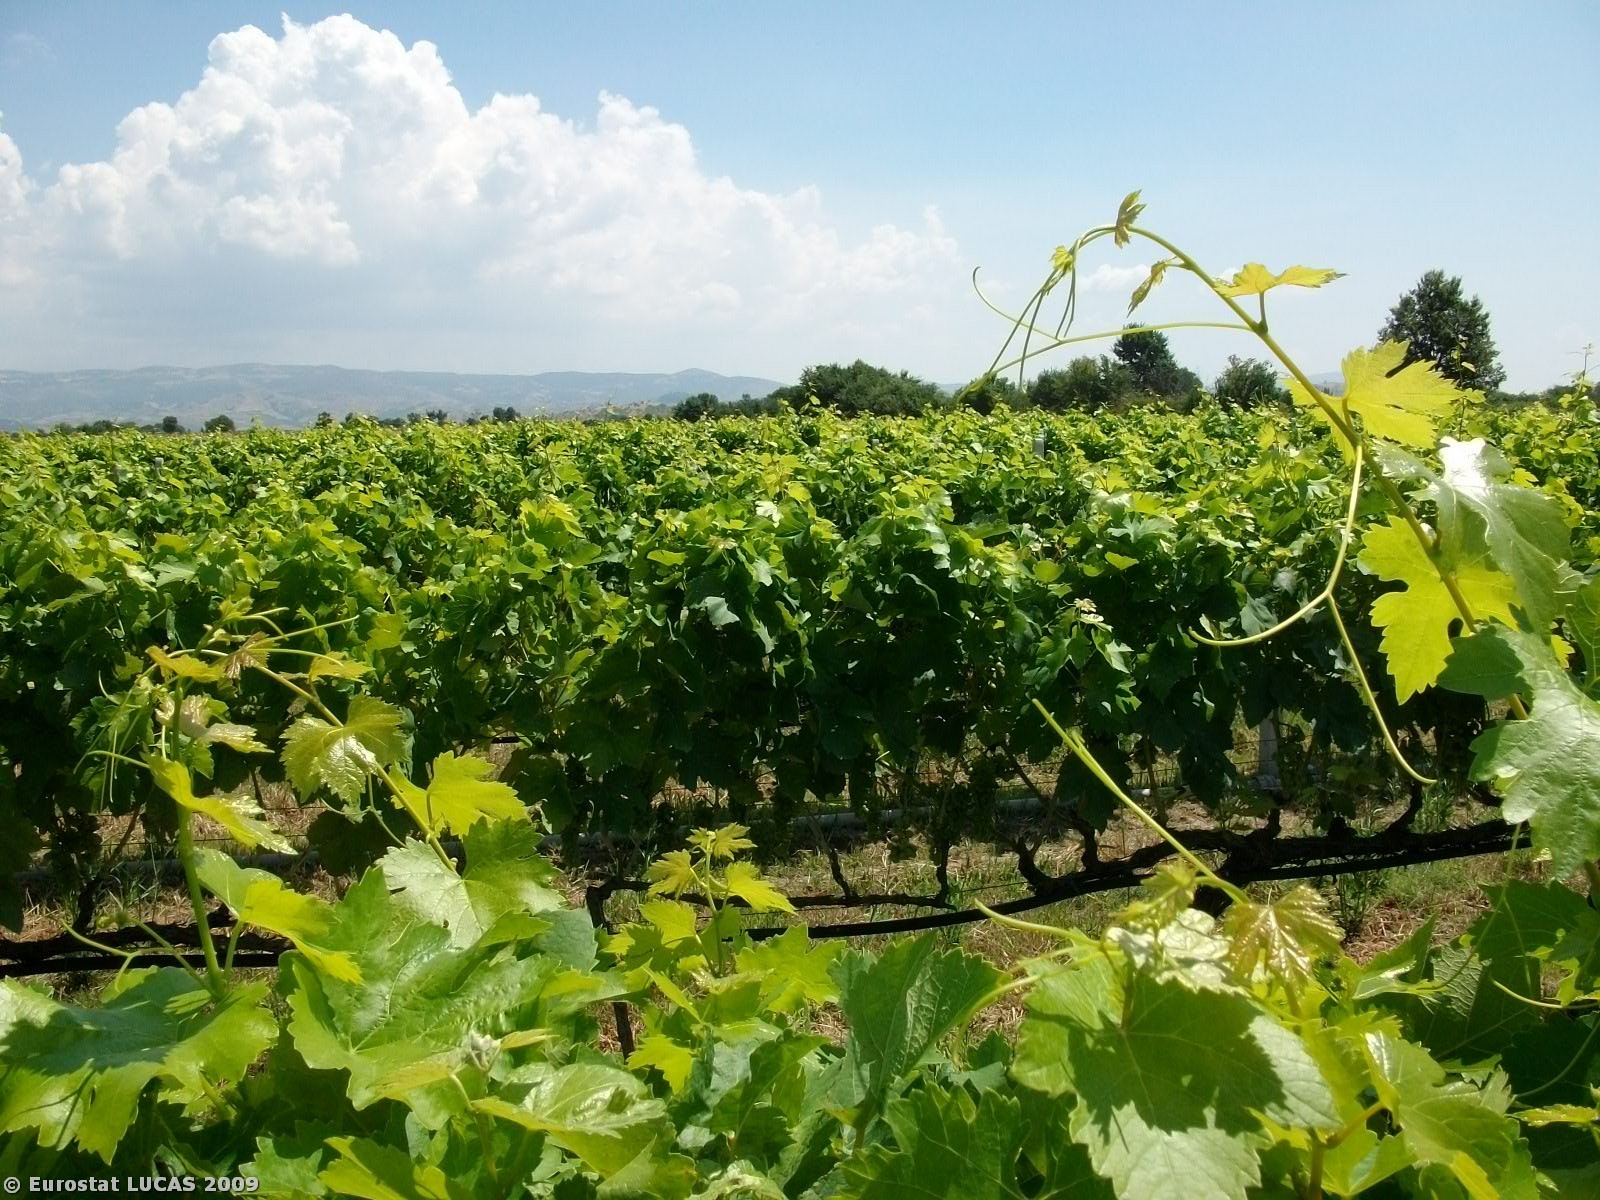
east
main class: Cropland
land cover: Vineyards
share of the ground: 25 - 50 %
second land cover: Grassland with sparse tree/shrub cover
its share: > 75 %
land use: Agriculture (excluding fallow land and kitchen gardens)
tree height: < 5 m
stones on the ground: < 10 %
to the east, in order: Vineyards; Grassland with sparse tree/shrub cover; Durum wheat; Shrubland with sparse tree cover; Tracks; Durum wheat; Tracks; Vineyards; Bare land
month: July
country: GR
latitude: 39.6000
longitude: 21.7106
